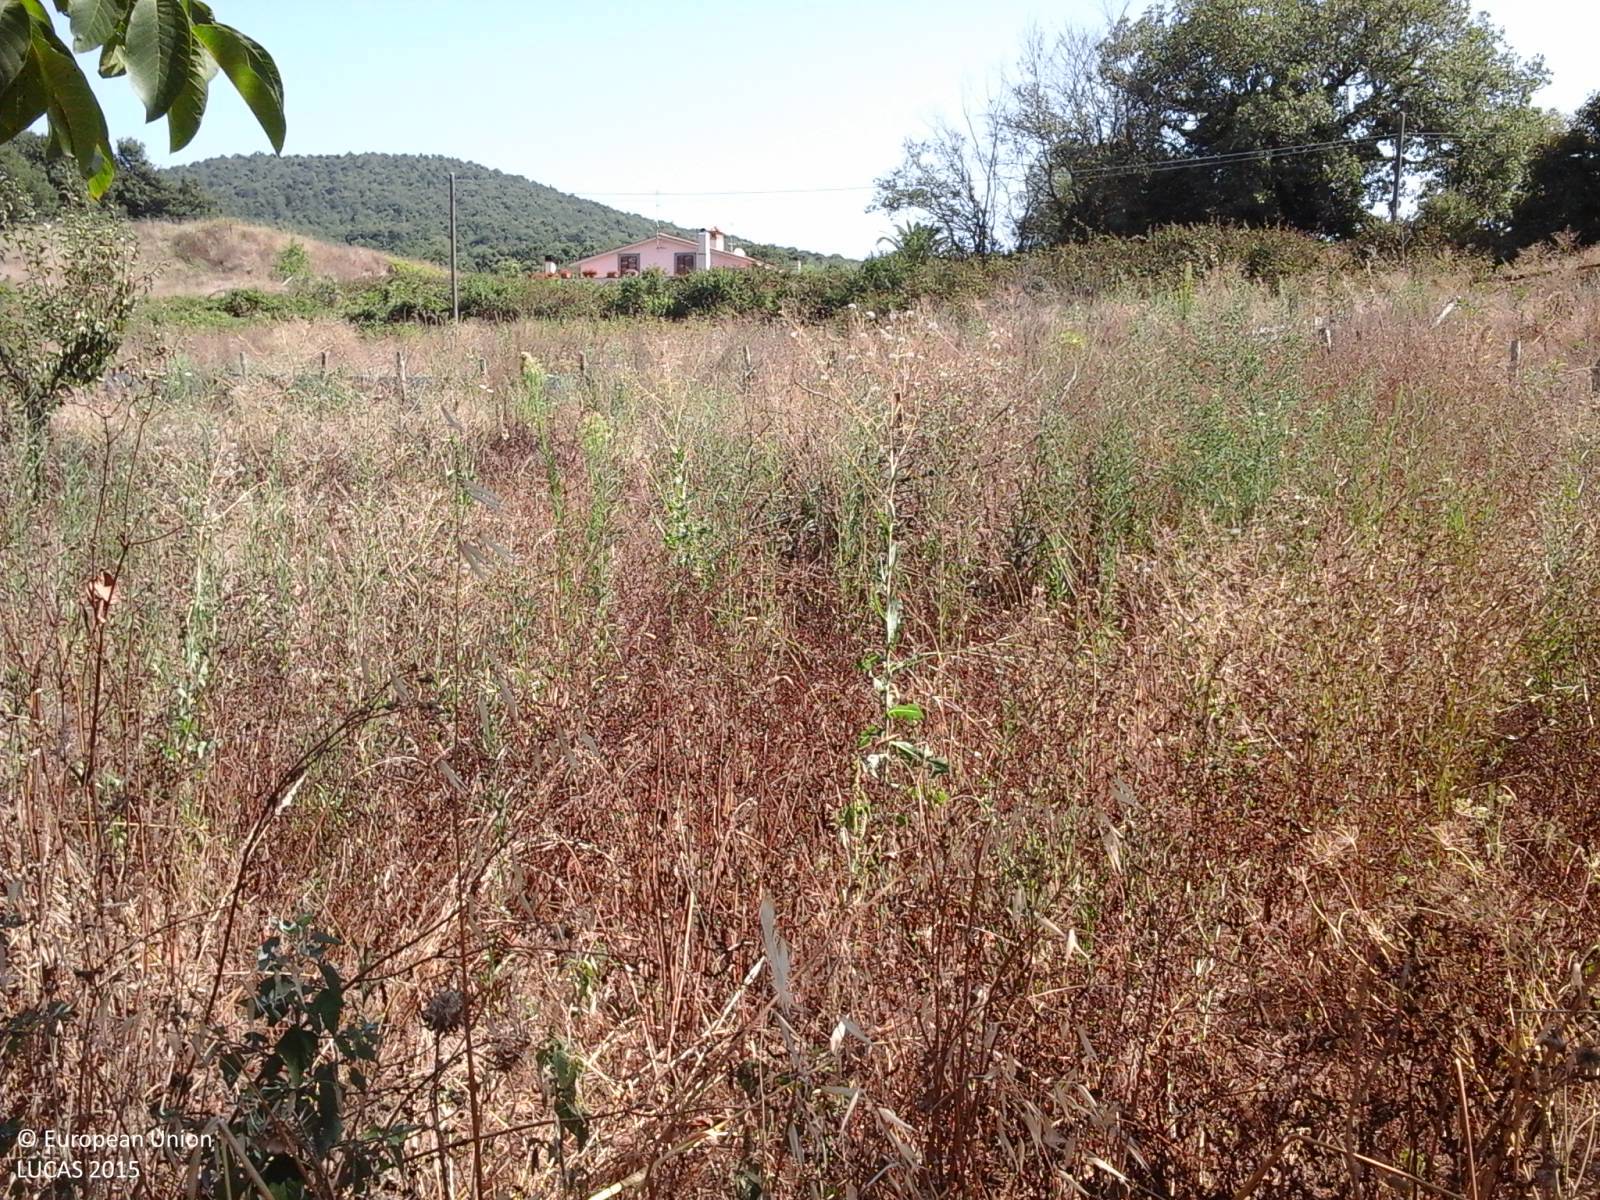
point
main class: Grassland
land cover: Grassland with sparse tree/shrub cover
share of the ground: > 75 %
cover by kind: herbaceous plants 95 %, broadleaved forest trees 5 %
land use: Agriculture (excluding fallow land and kitchen gardens)
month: August
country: IT
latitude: 42.1585
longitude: 12.2793
